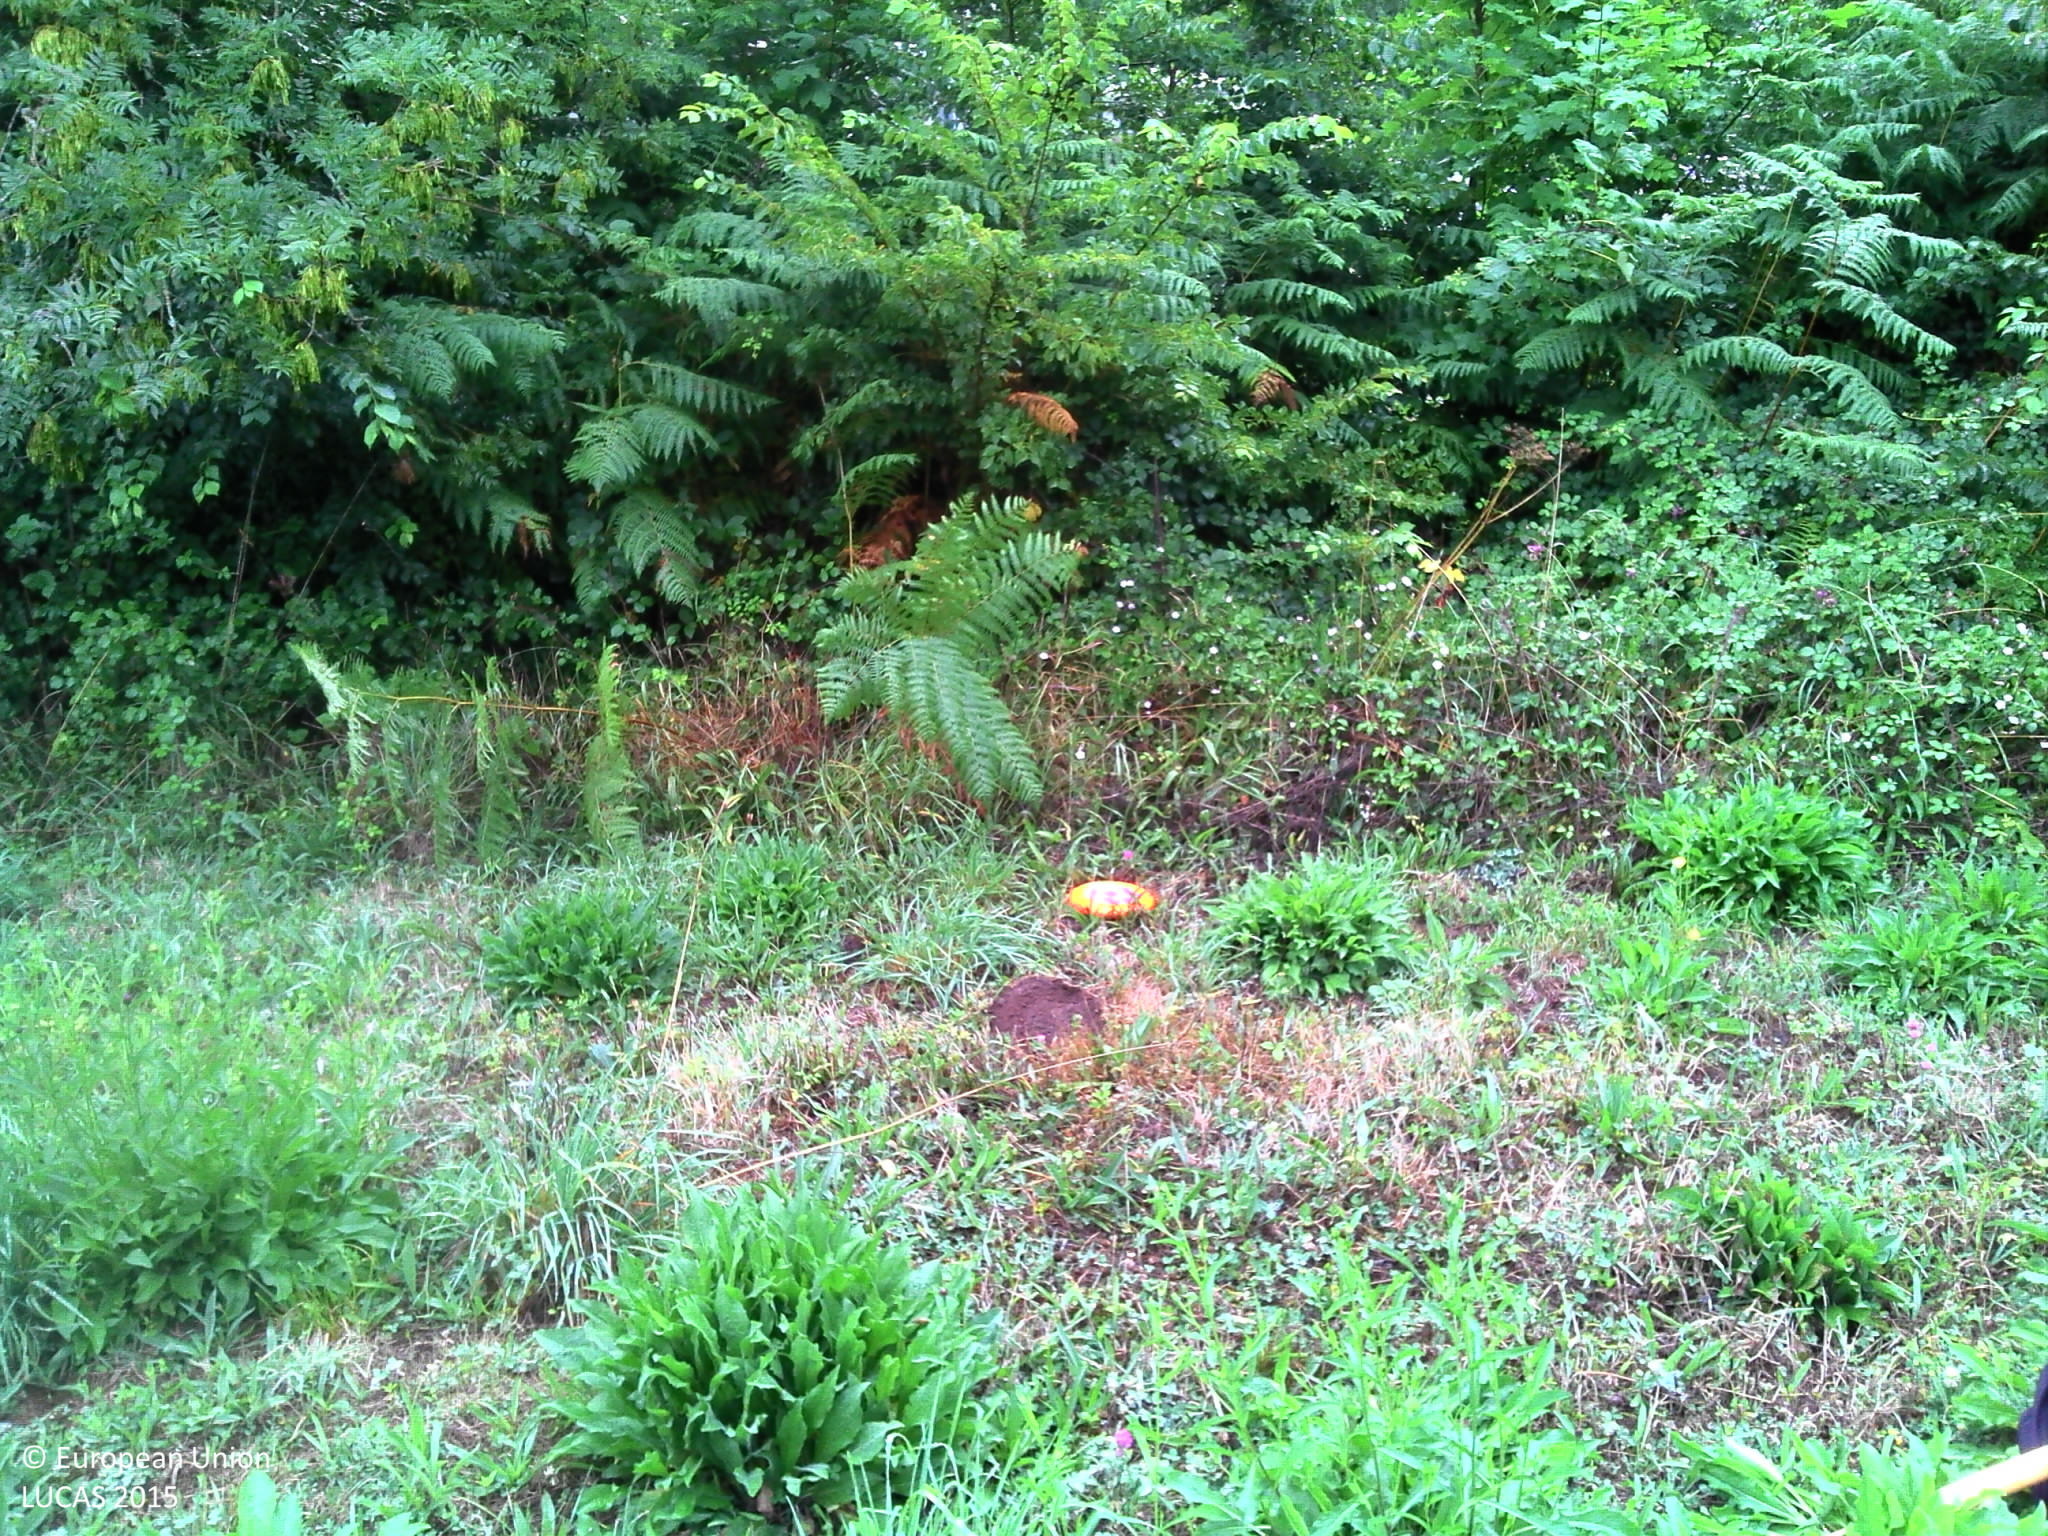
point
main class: Grassland
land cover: Grassland without tree/shrub cover
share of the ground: > 75 %
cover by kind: herbaceous plants 80 %, consolidated bare surface 20 %
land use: Agriculture (excluding fallow land and kitchen gardens)
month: July
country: FR
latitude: 47.6321
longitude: -3.1506
